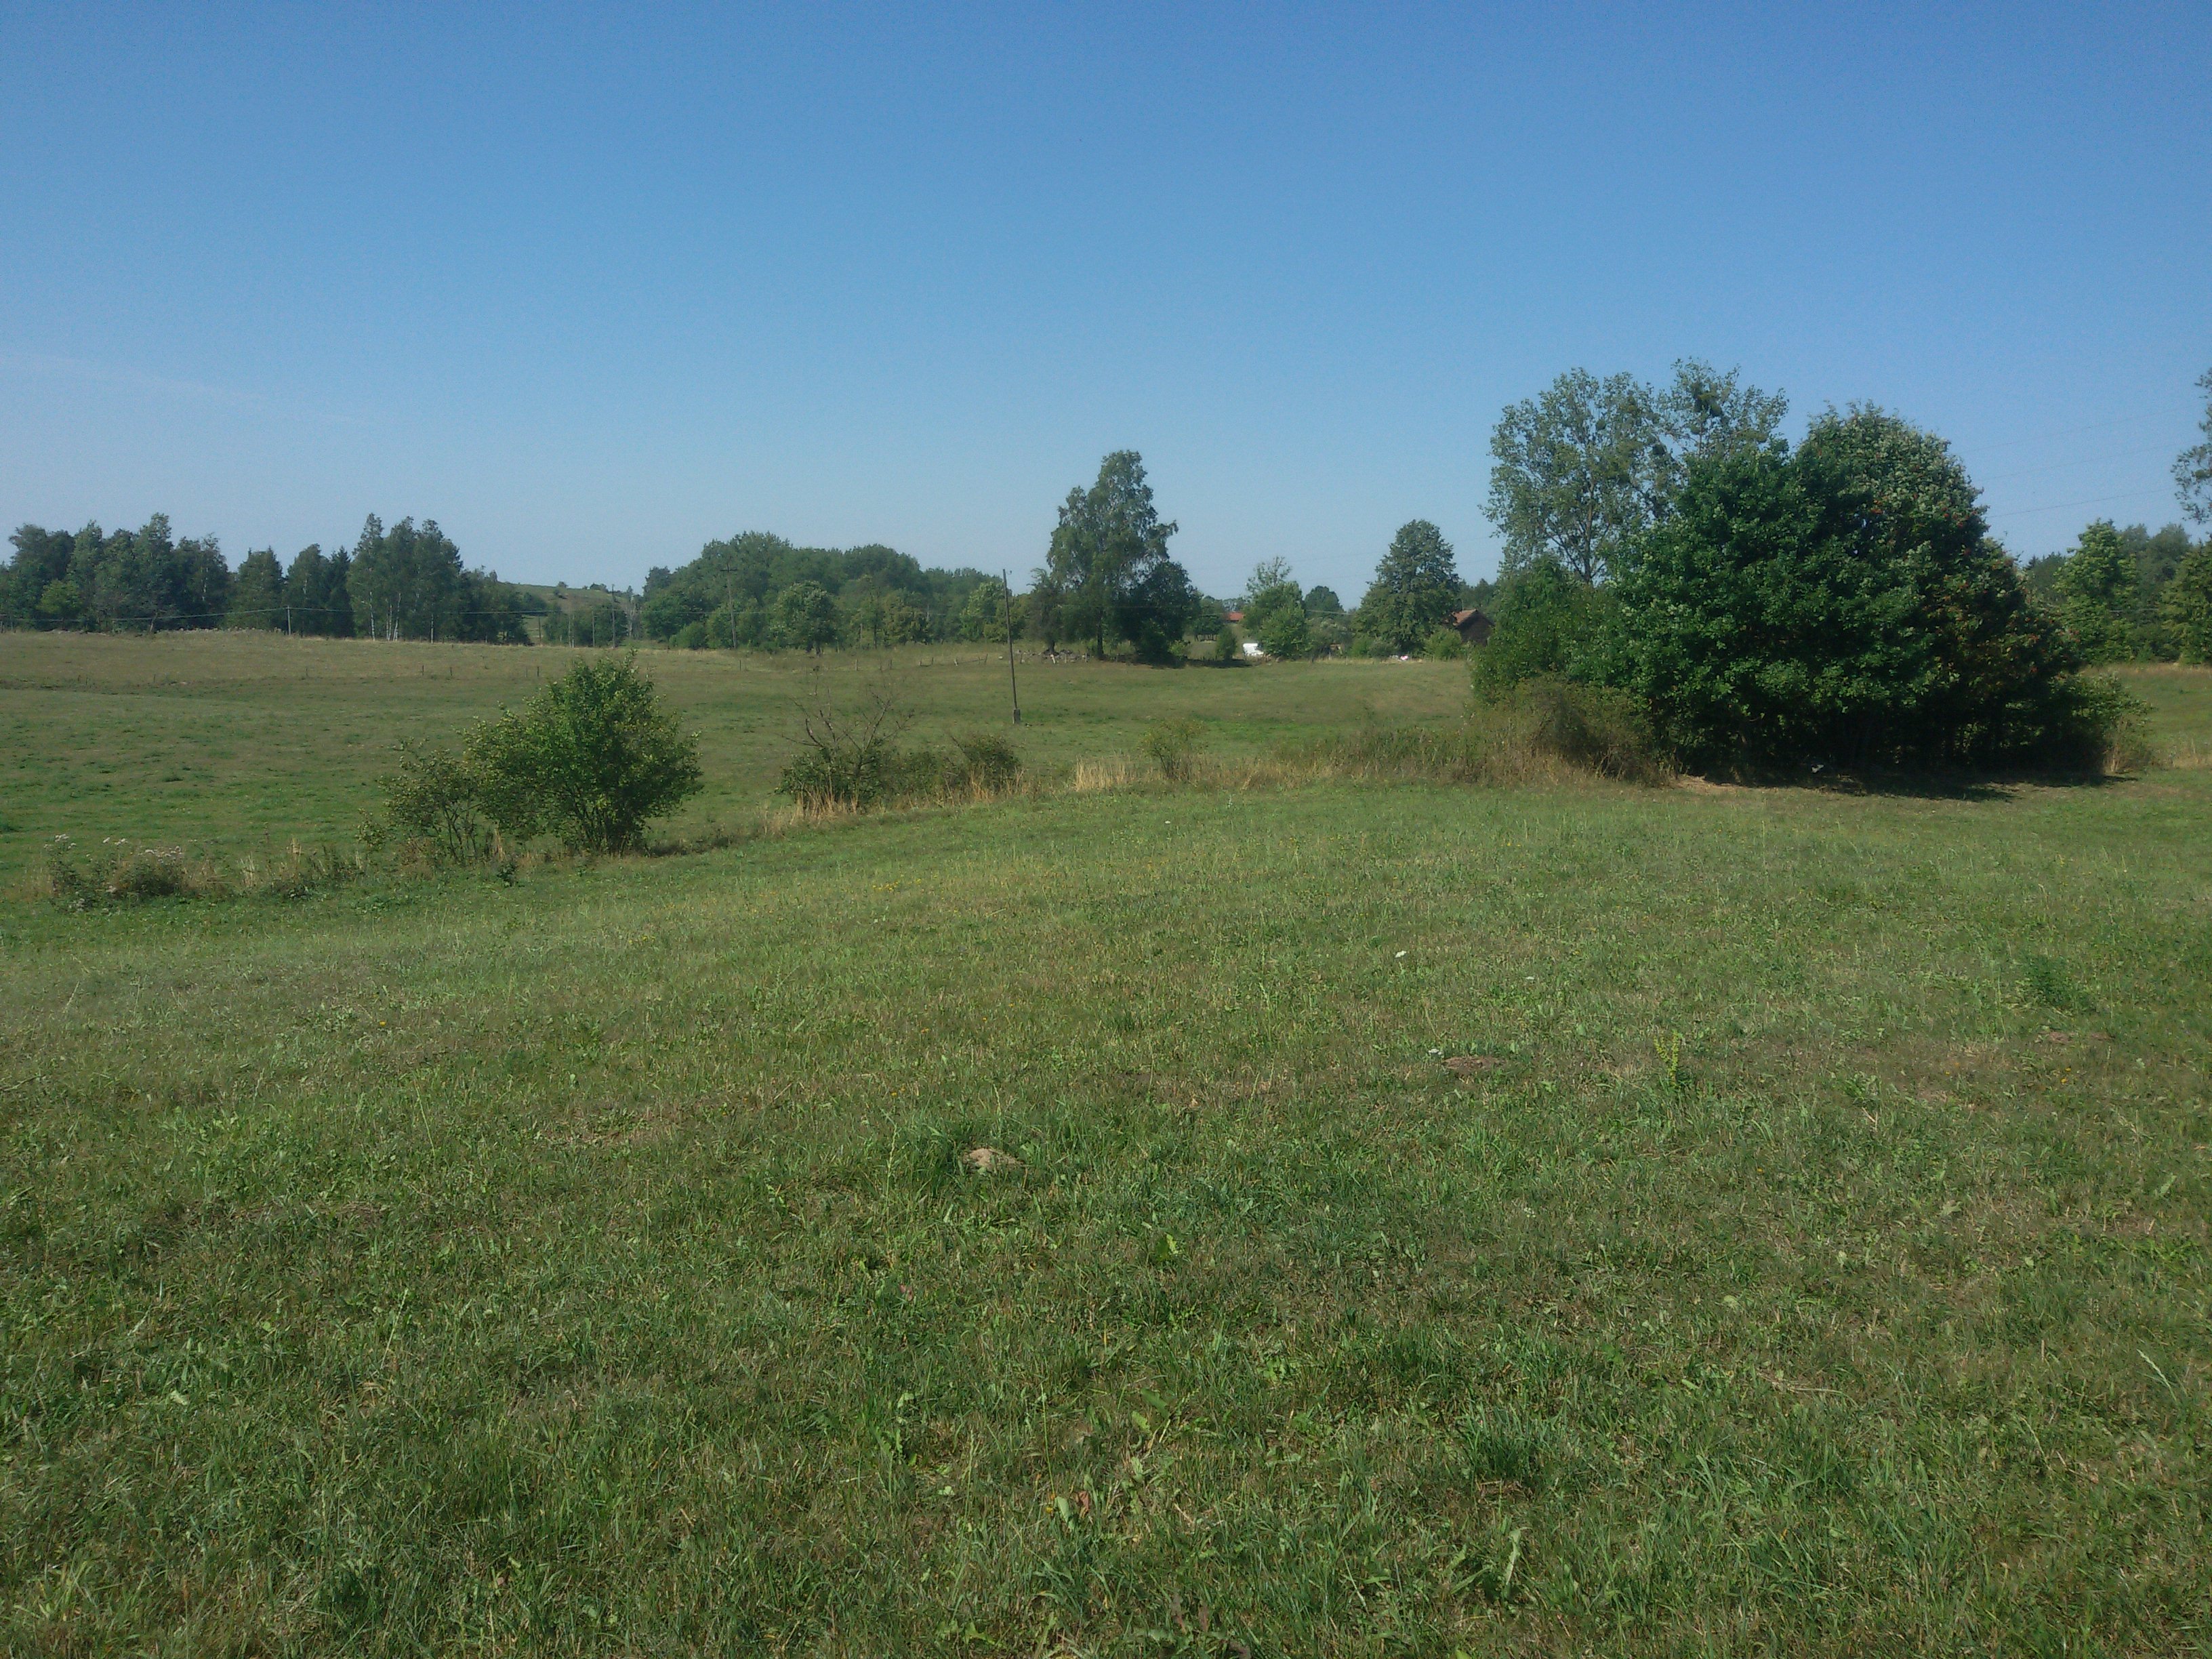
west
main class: Grassland
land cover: Grassland without tree/shrub cover
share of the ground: > 75 %
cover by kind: herbaceous plants 100 %
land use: Agriculture (excluding fallow land and kitchen gardens)
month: August
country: PL
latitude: 53.9207
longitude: 21.1449
